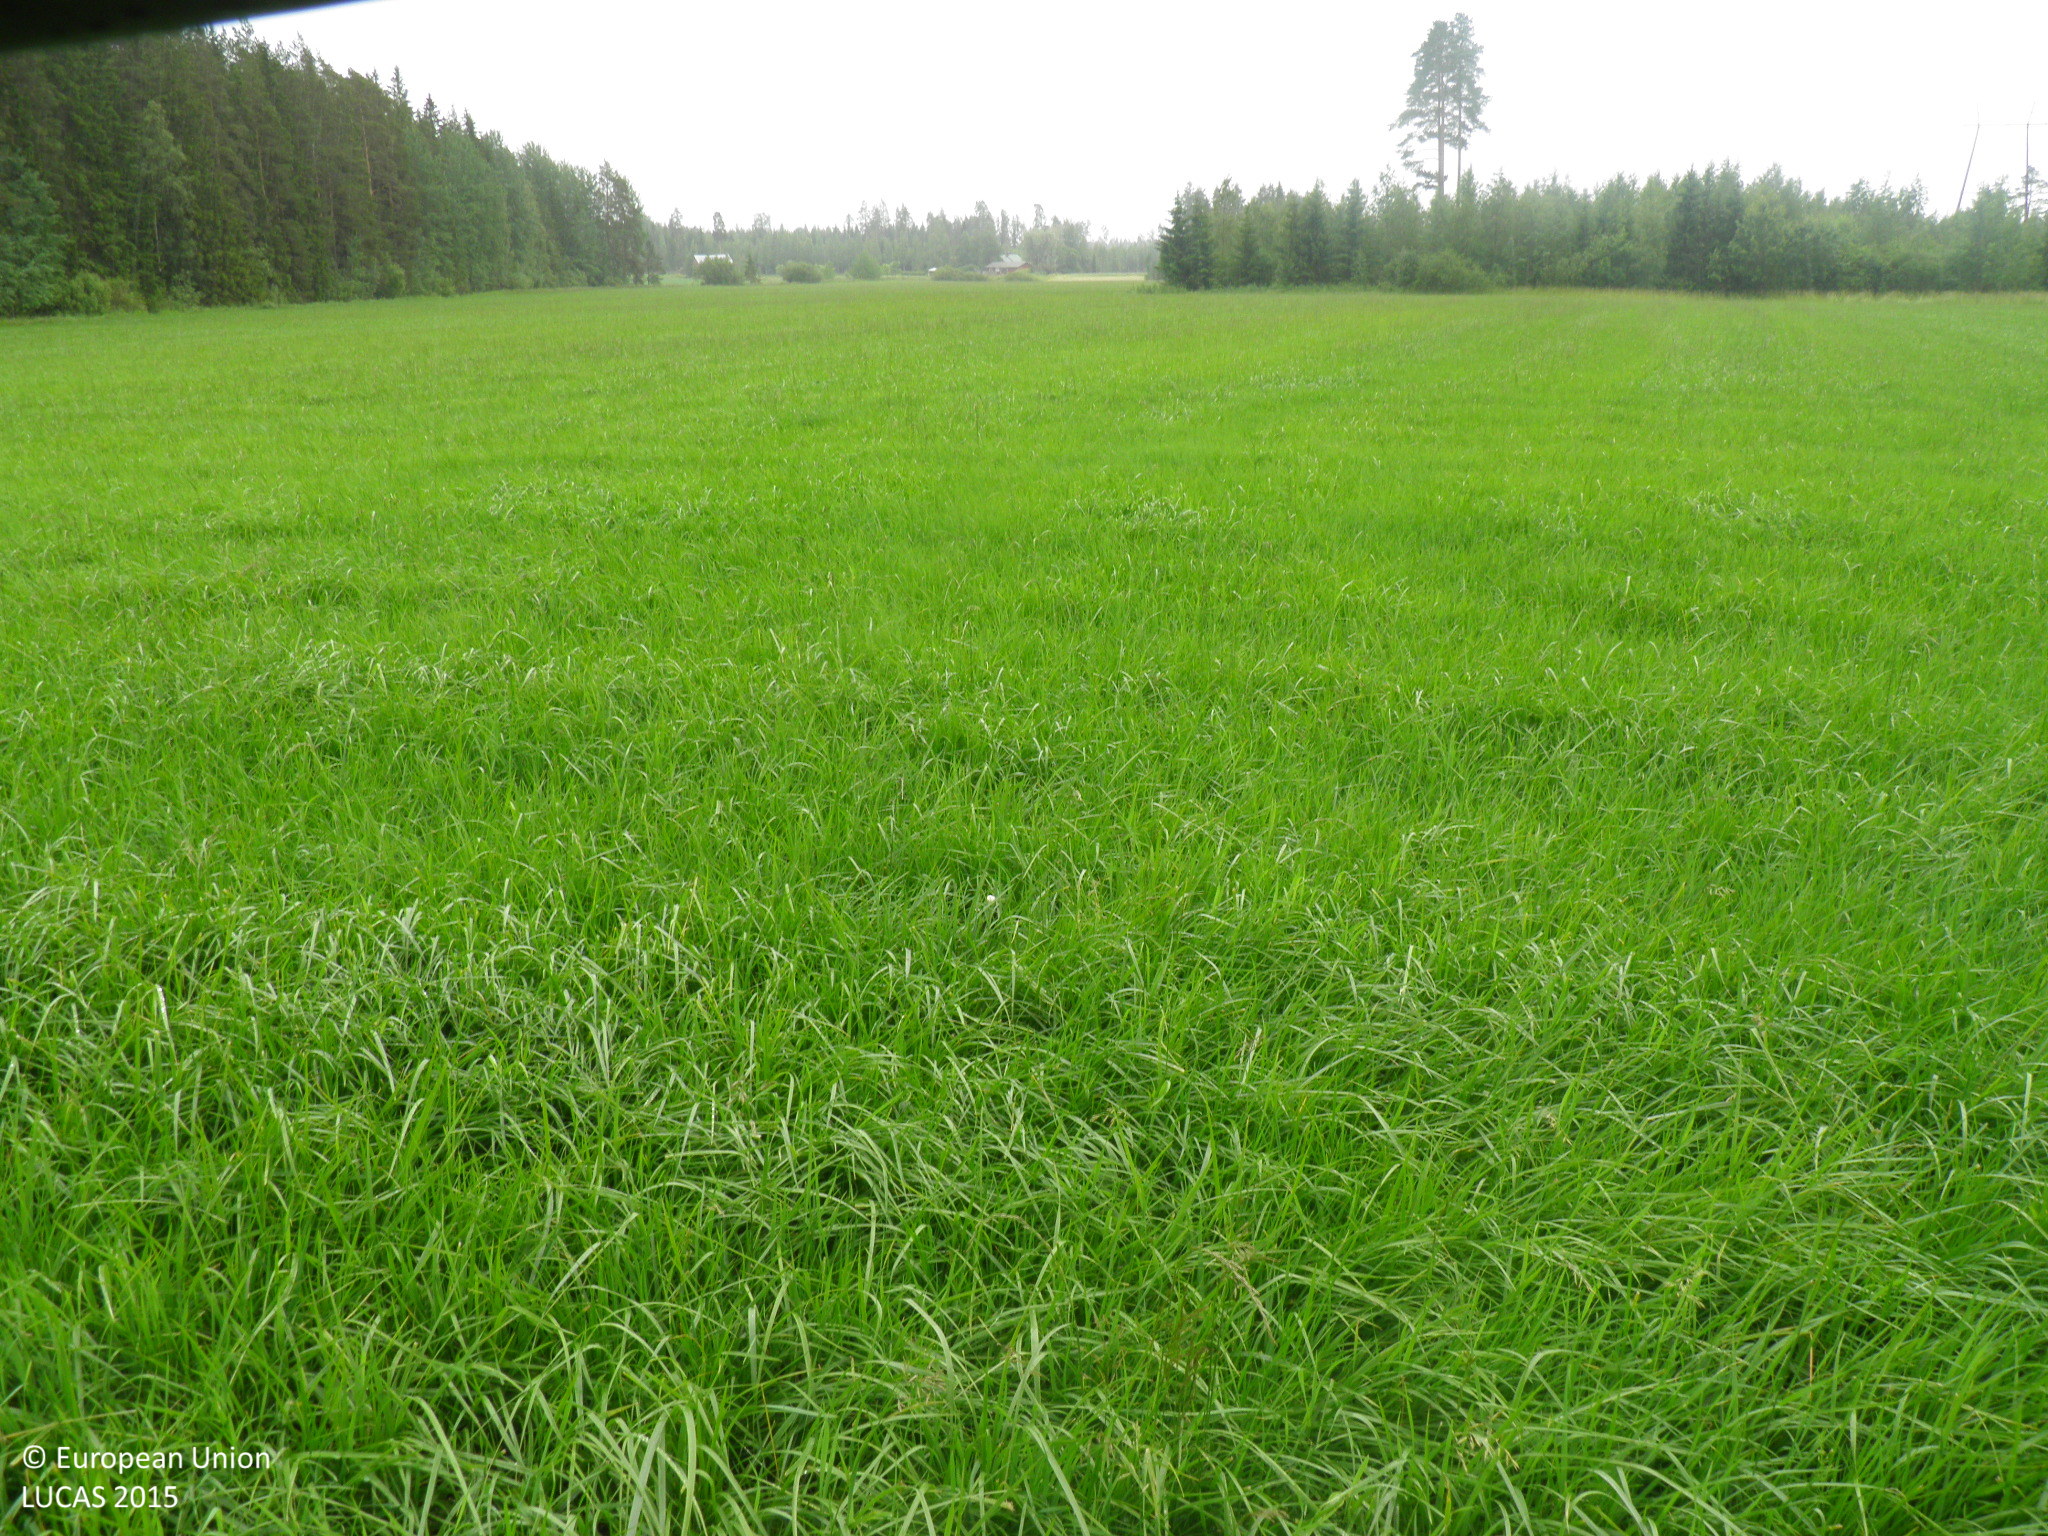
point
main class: Cropland
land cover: Temporary grasslands
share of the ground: > 75 %
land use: Agriculture (excluding fallow land and kitchen gardens)
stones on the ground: < 10 %
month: July
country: FI
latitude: 60.6556
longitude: 22.7874
